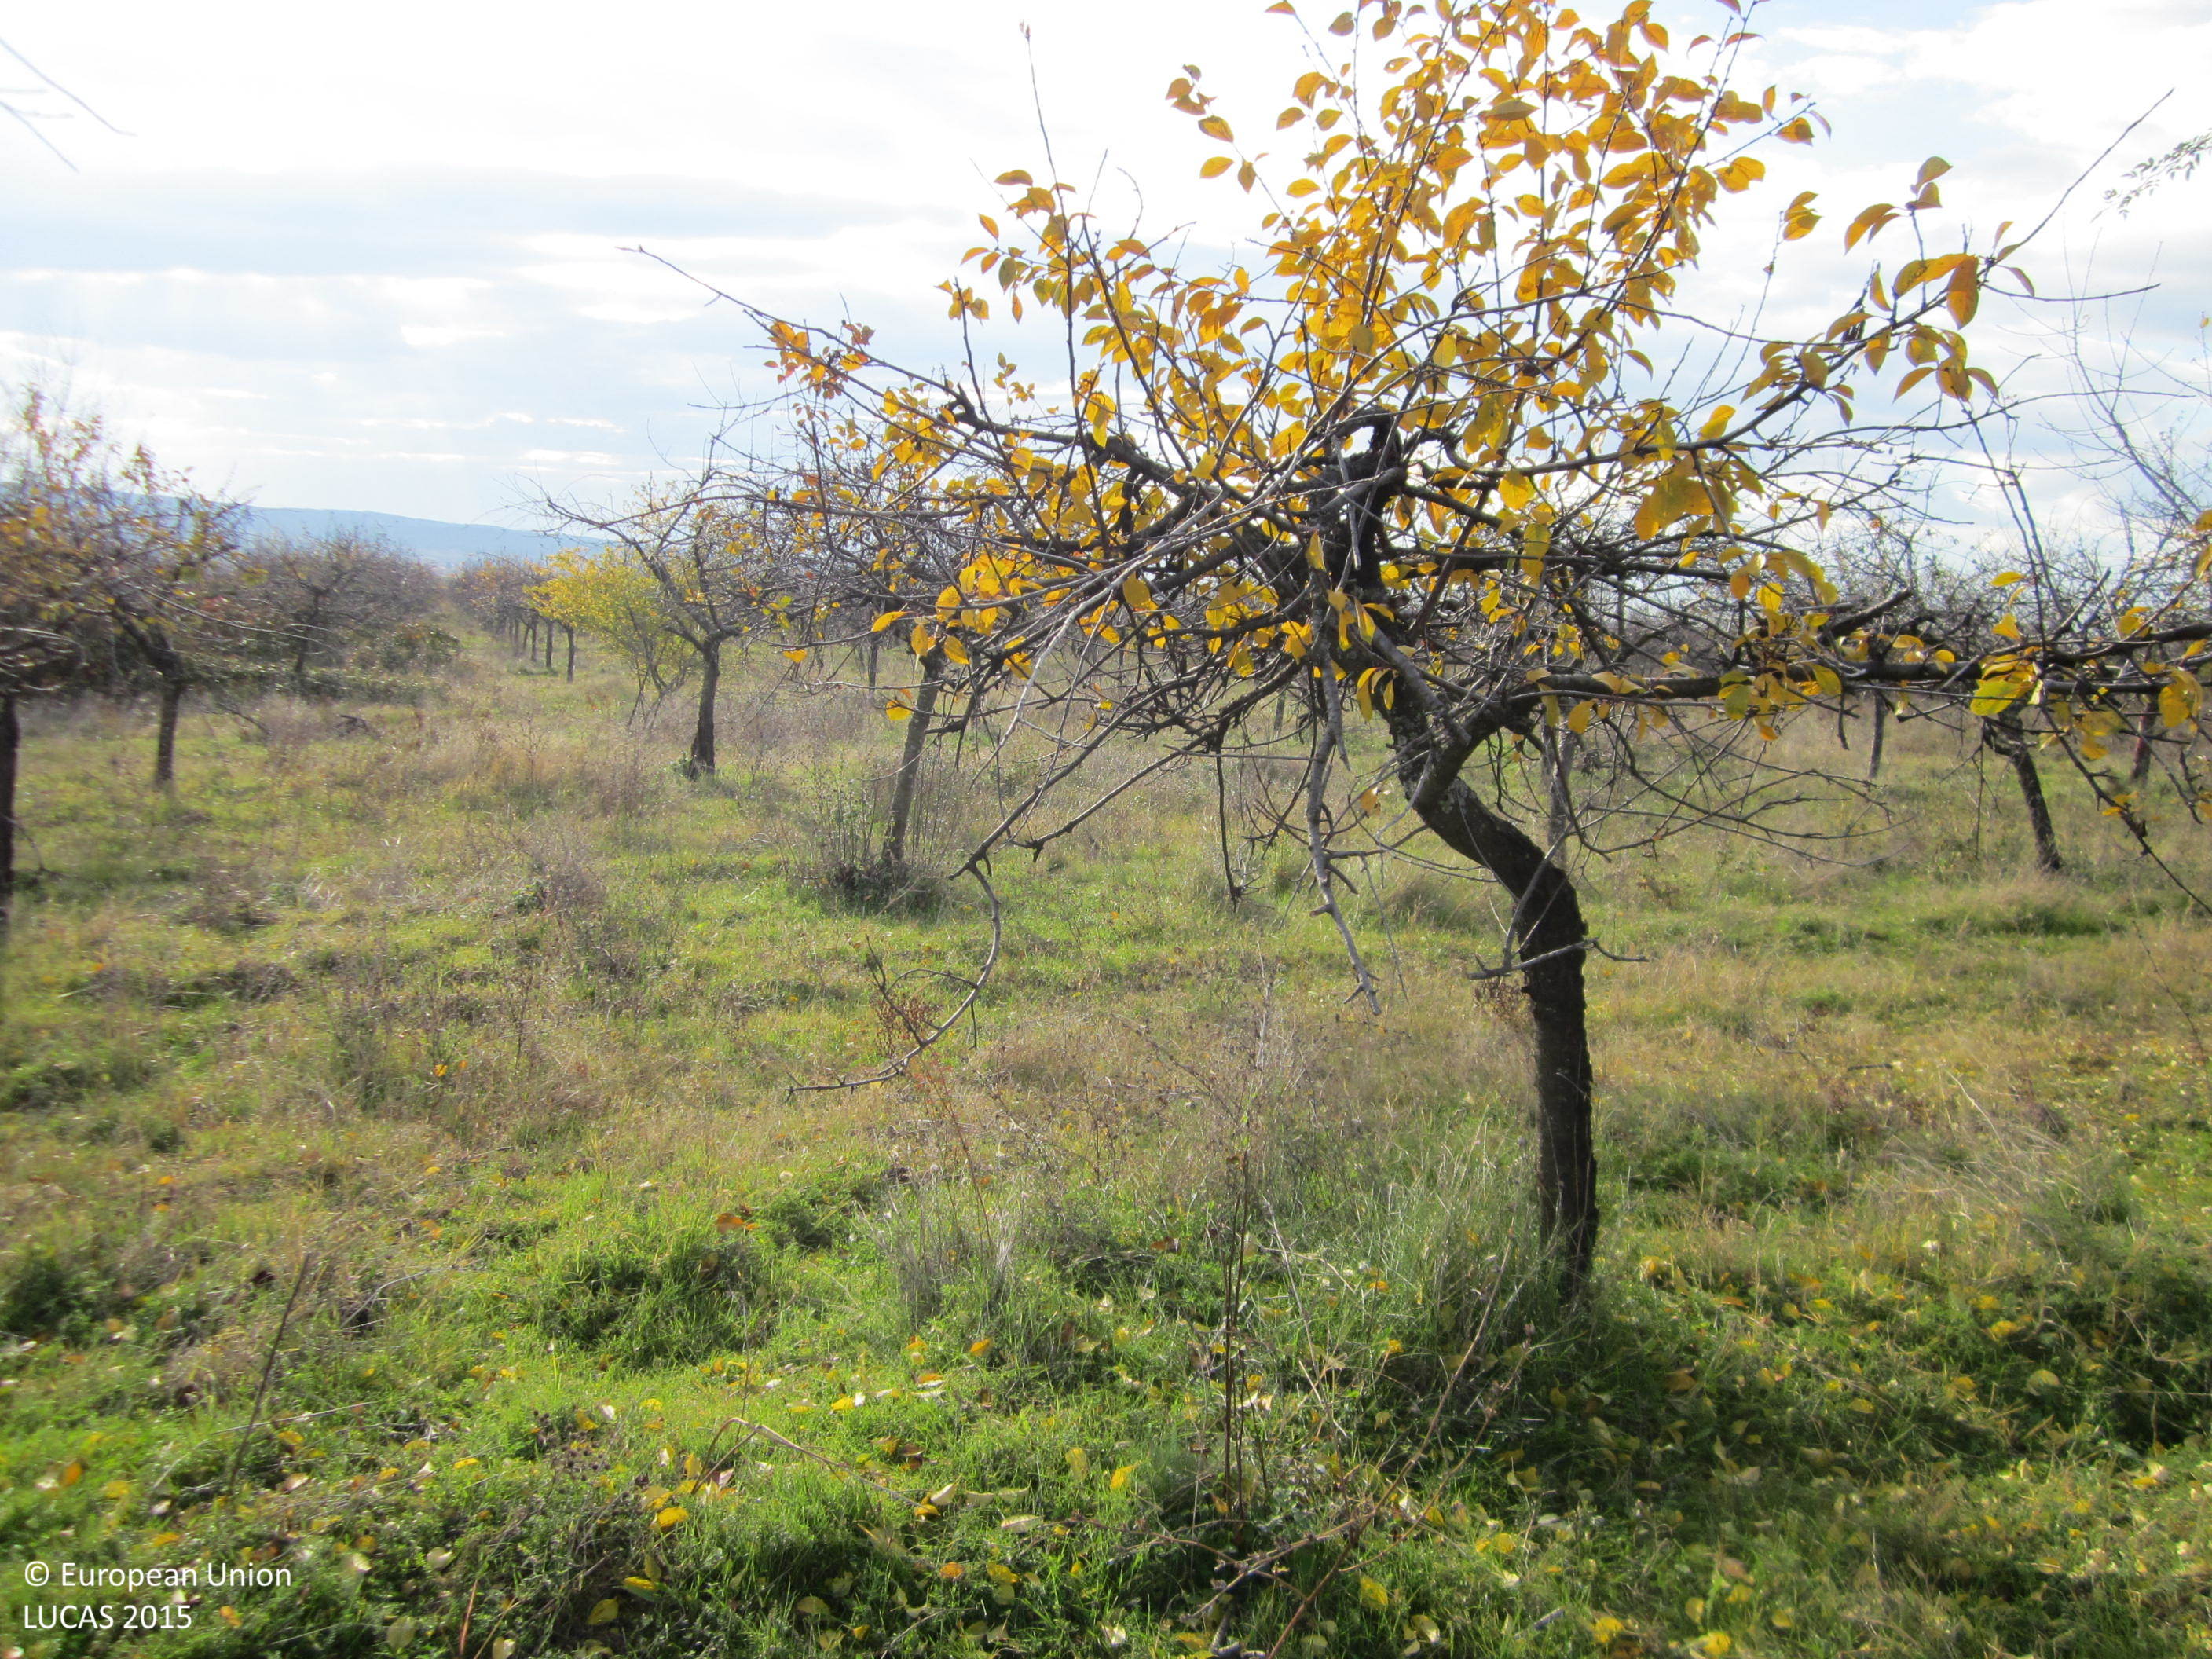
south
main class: Cropland
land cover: Cherry fruit
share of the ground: 50 - 75 %
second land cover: Grassland without tree/shrub cover
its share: > 75 %
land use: Agriculture (excluding fallow land and kitchen gardens)
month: November
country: BG
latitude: 42.5276
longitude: 24.7001
